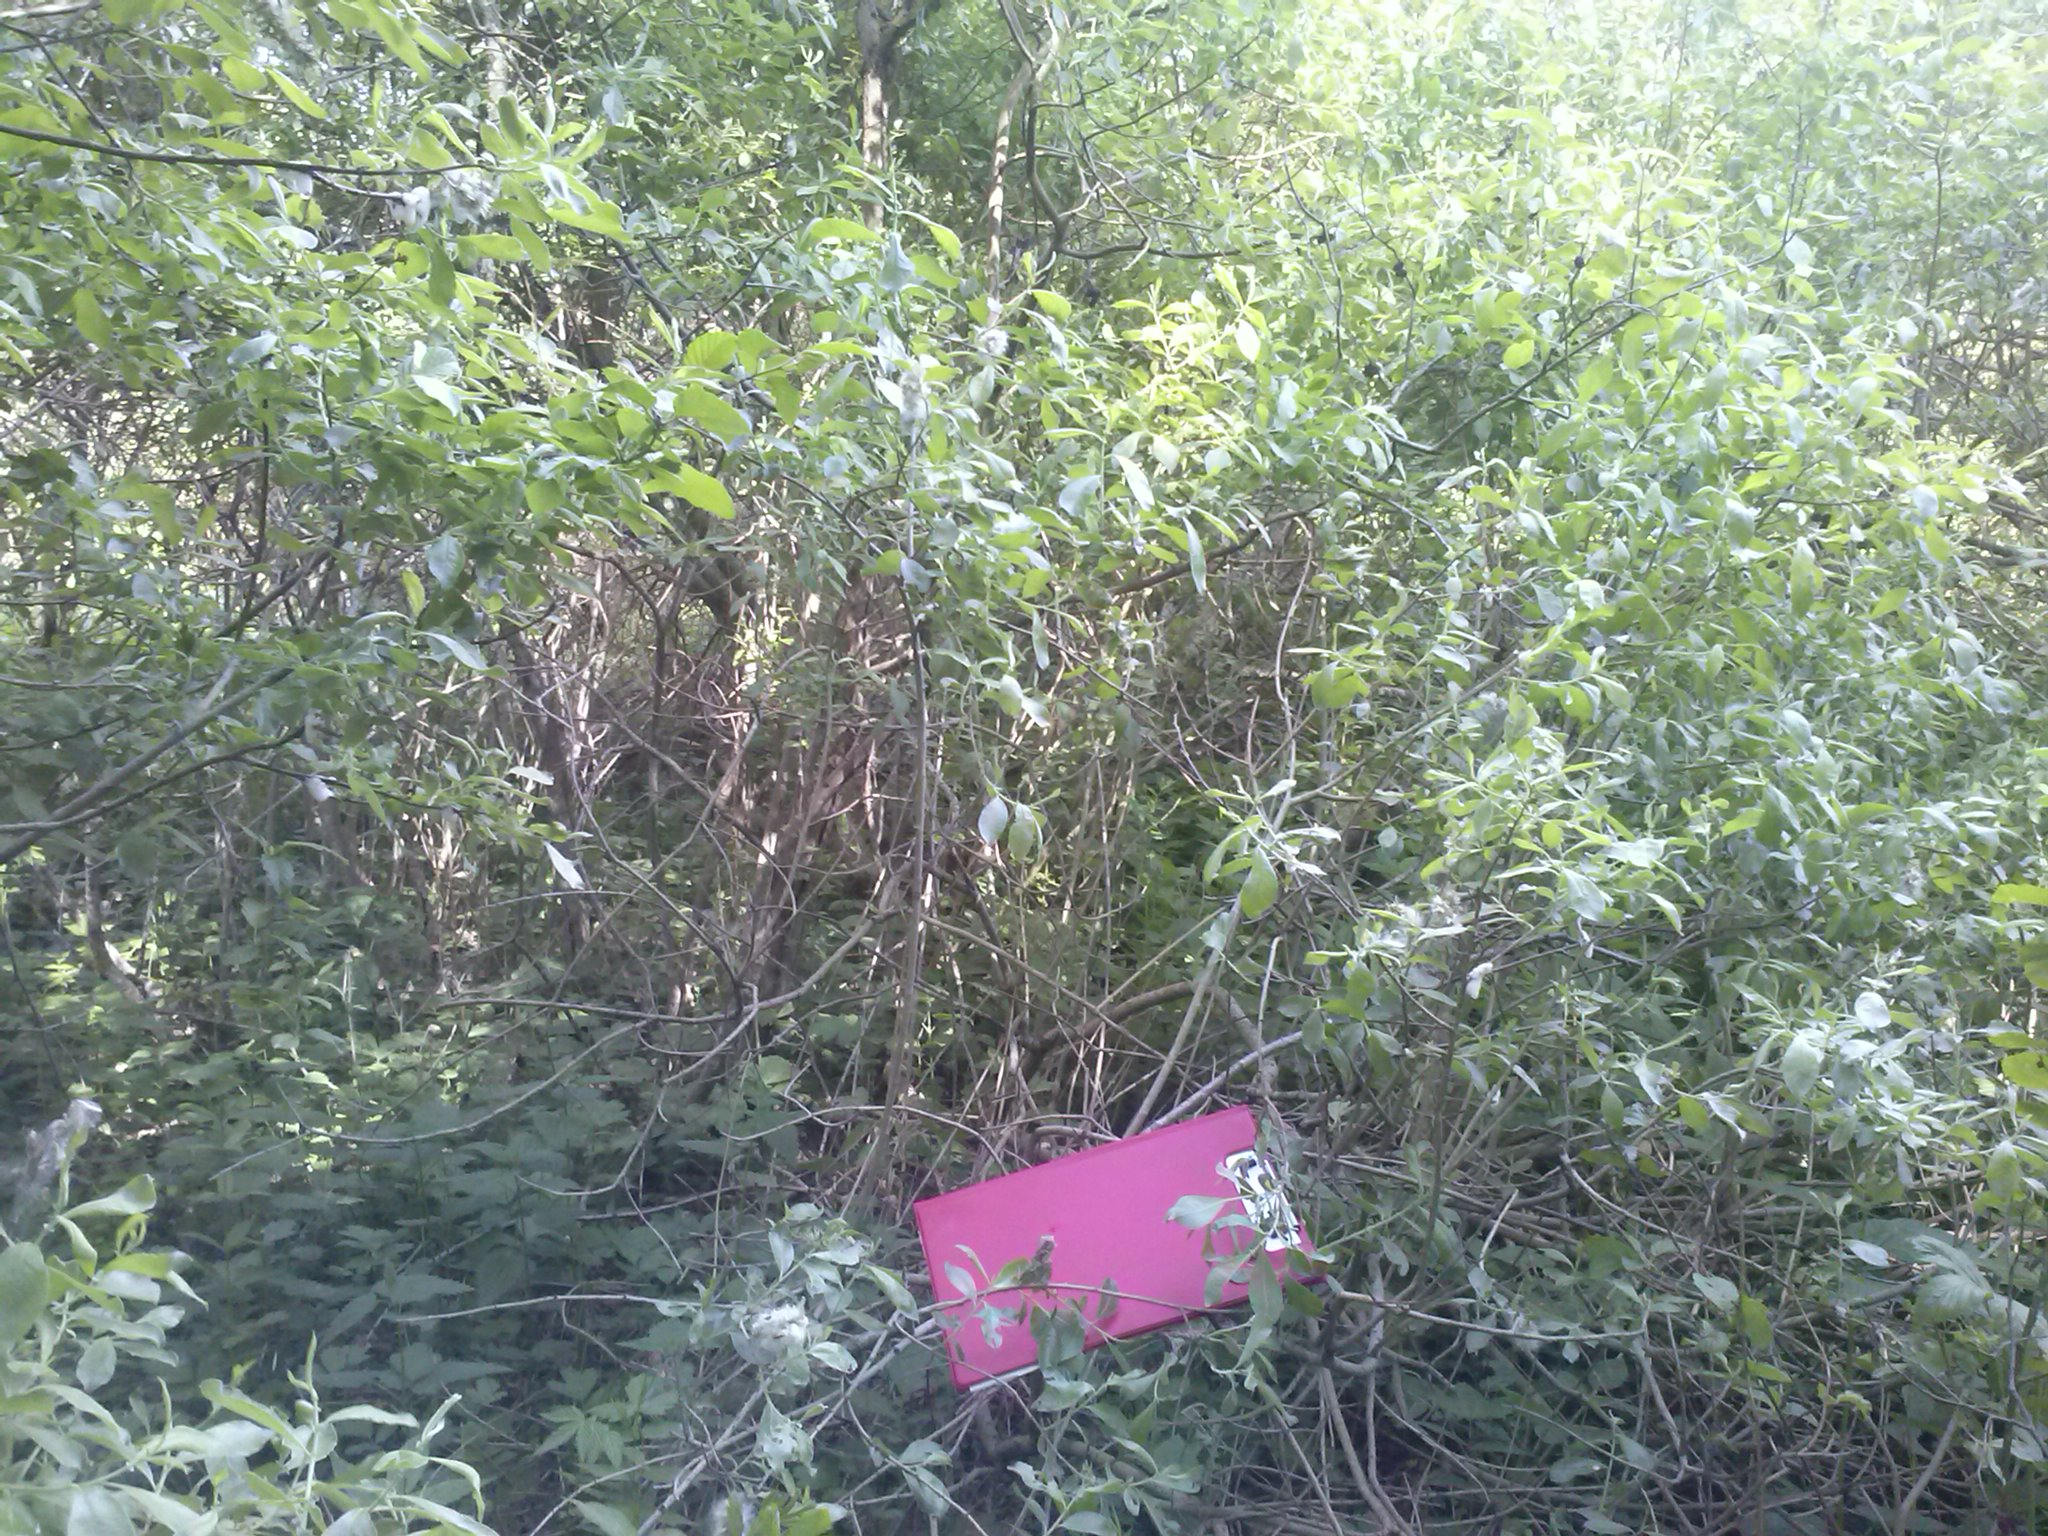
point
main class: Woodland
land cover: Broadleaved woodland
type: non-riverine alder, birch or aspen forest
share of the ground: > 75 %
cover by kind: broadleaved forest trees 100 %
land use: Forestry
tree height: > 5 m
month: June
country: LV
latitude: 56.3036
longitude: 26.7879
